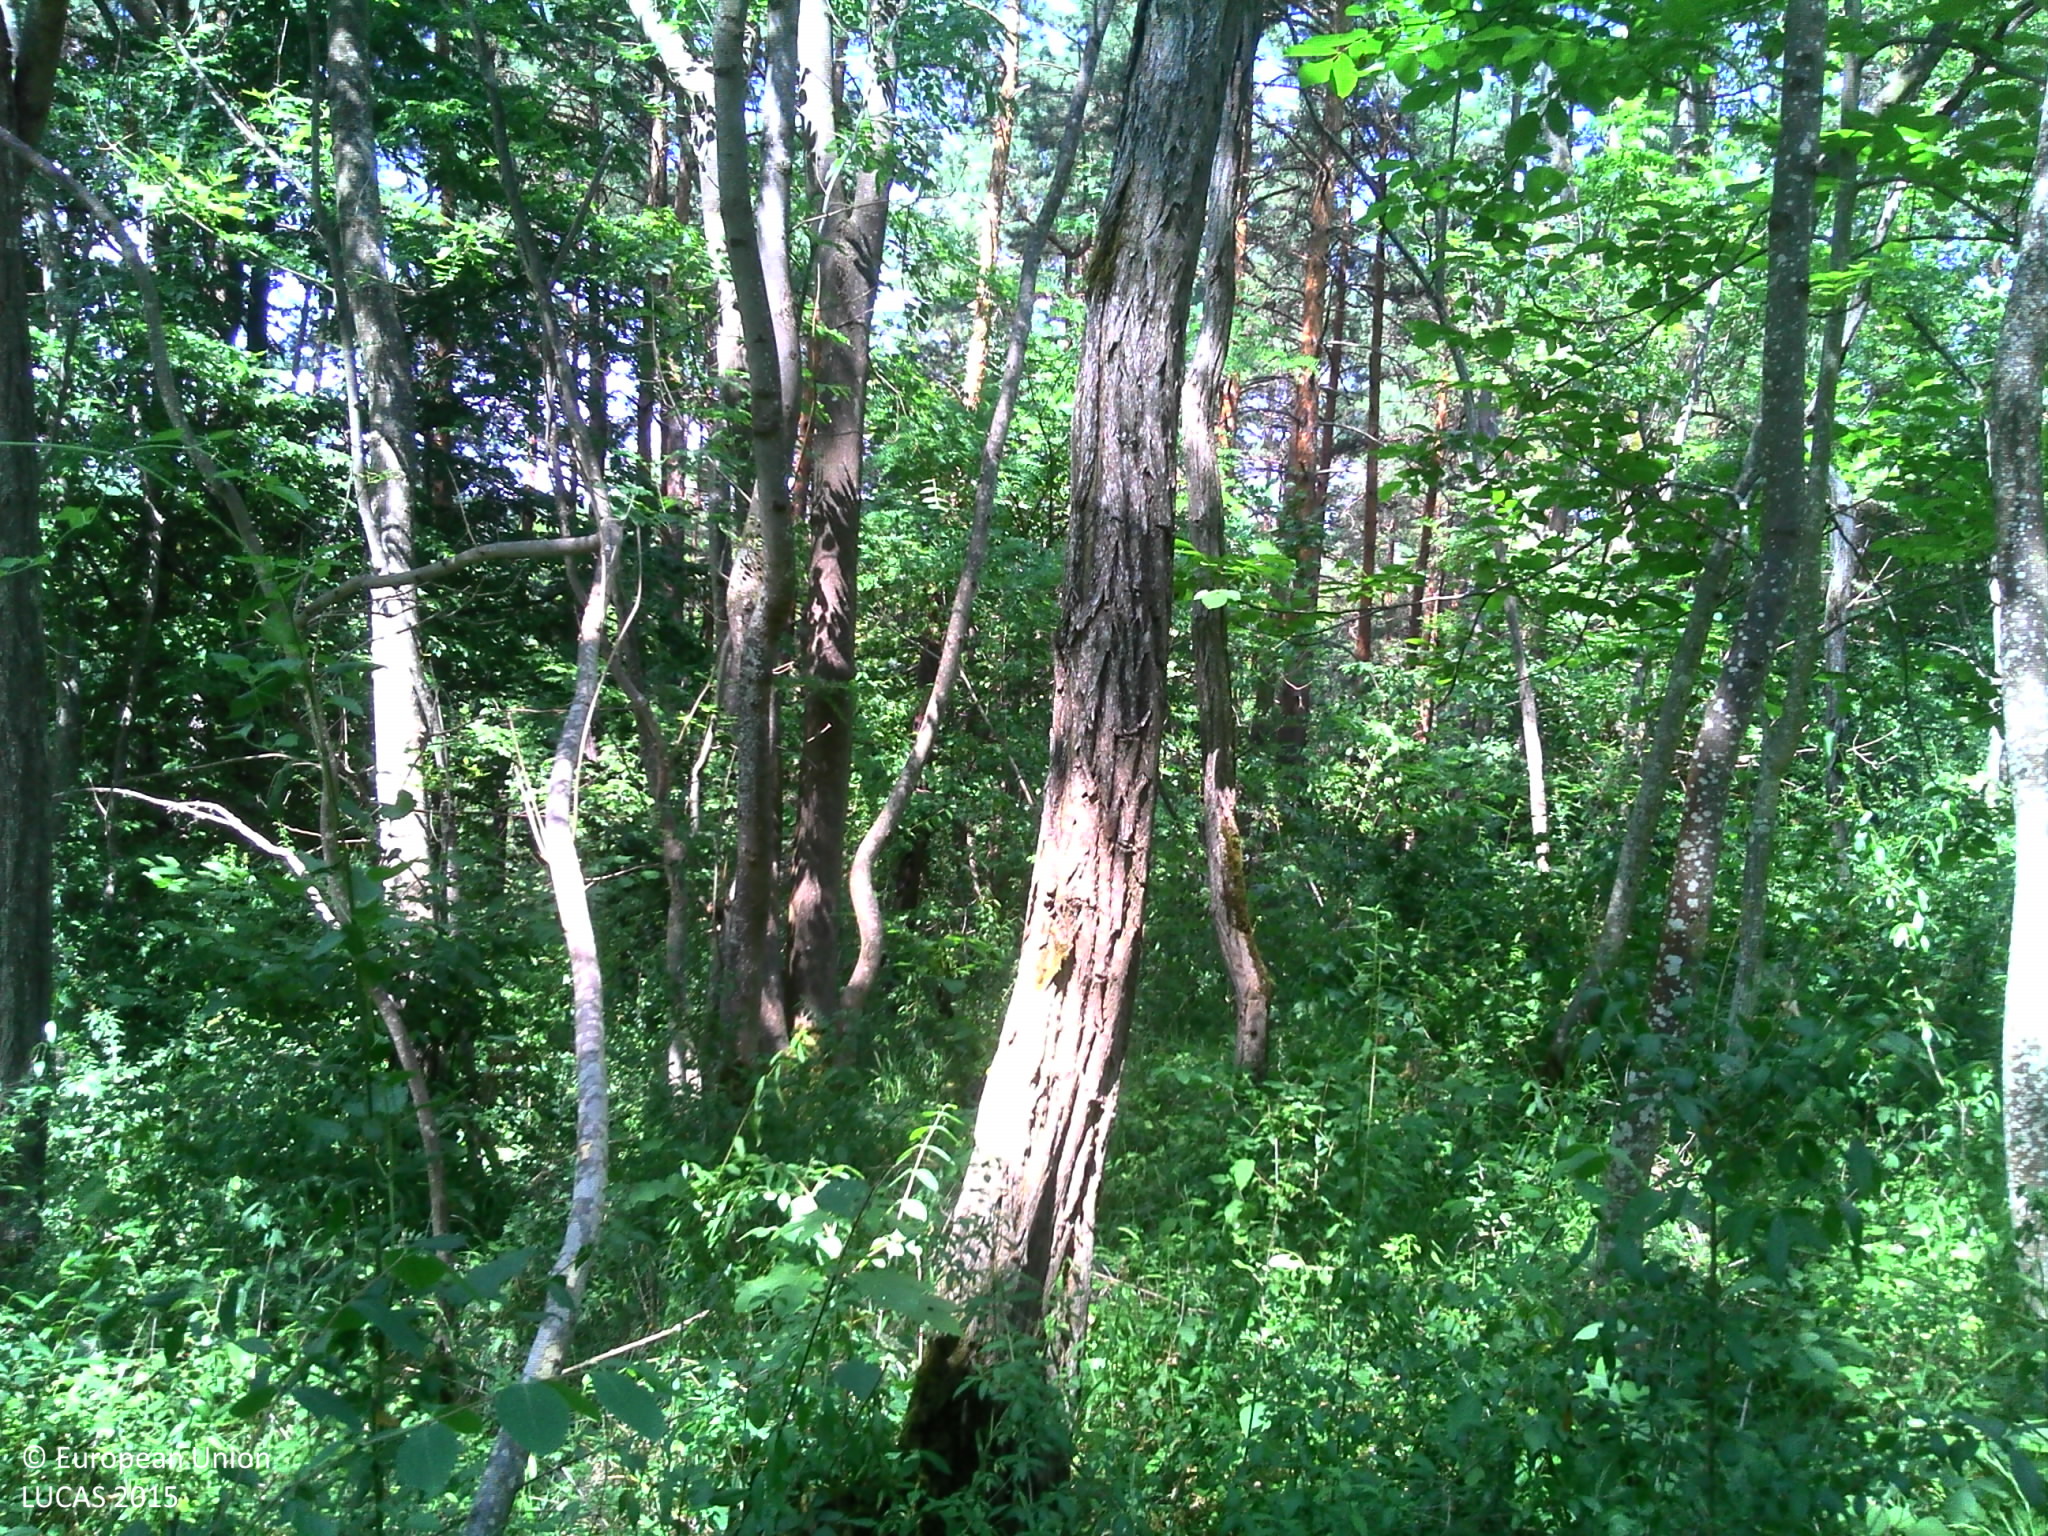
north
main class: Woodland
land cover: Broadleaved woodland
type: mesophytic deciduous forest
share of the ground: > 75 %
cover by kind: broadleaved forest trees 85 %, herbaceous plants 15 %
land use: Forestry
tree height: > 5 m
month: July
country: FR
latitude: 48.5545
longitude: 7.4673
